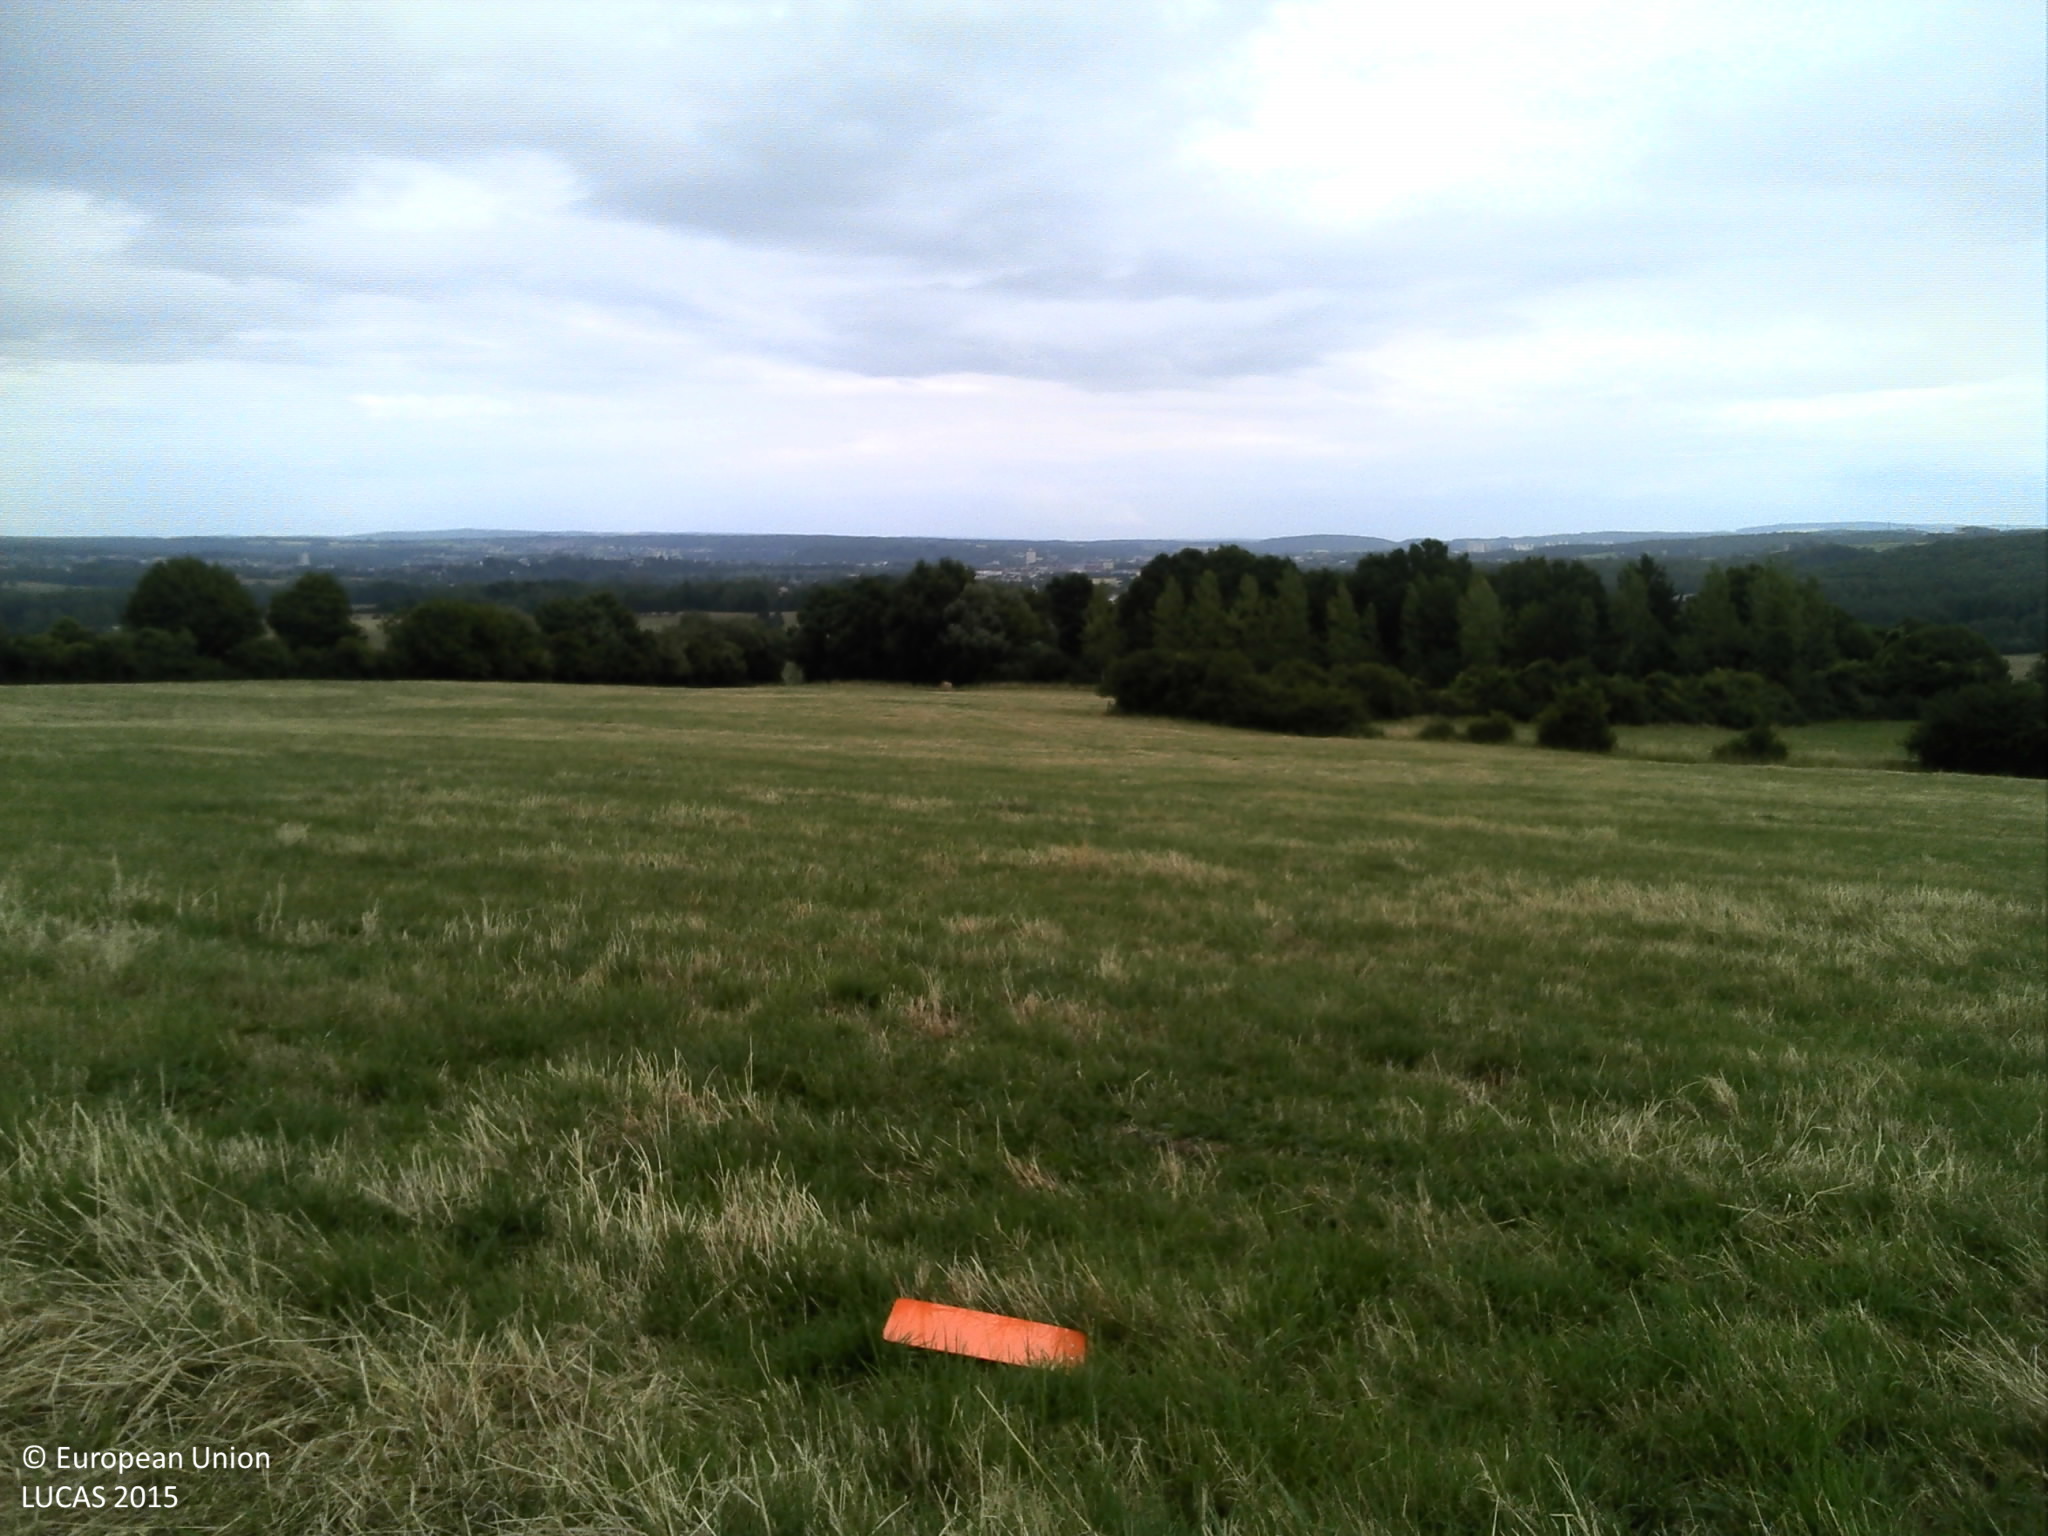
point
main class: Grassland
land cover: Grassland without tree/shrub cover
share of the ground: > 75 %
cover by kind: herbaceous plants 100 %
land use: Agriculture (excluding fallow land and kitchen gardens)
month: July
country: FR
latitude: 49.7691
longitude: 4.6231
